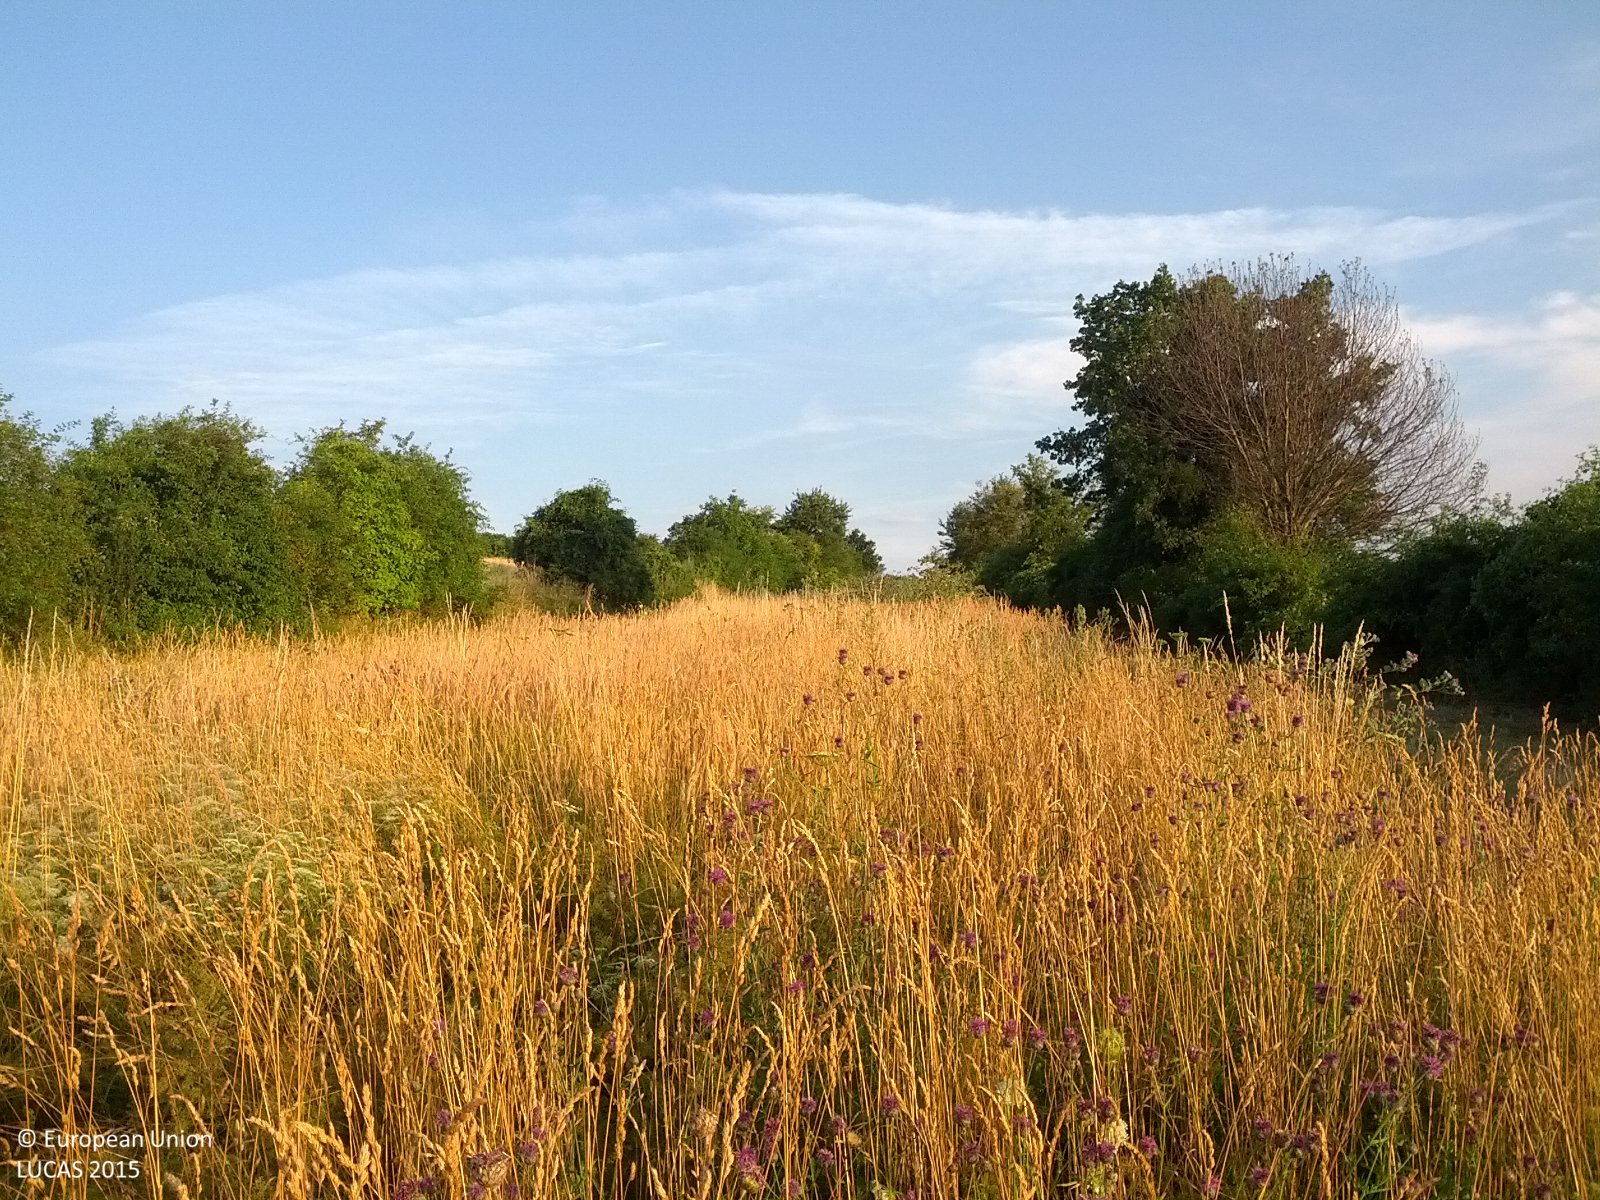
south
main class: Grassland
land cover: Grassland without tree/shrub cover
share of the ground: > 75 %
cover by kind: herbaceous plants 100 %
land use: Agriculture (excluding fallow land and kitchen gardens)
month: July
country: AT
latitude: 48.6216
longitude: 16.2865
